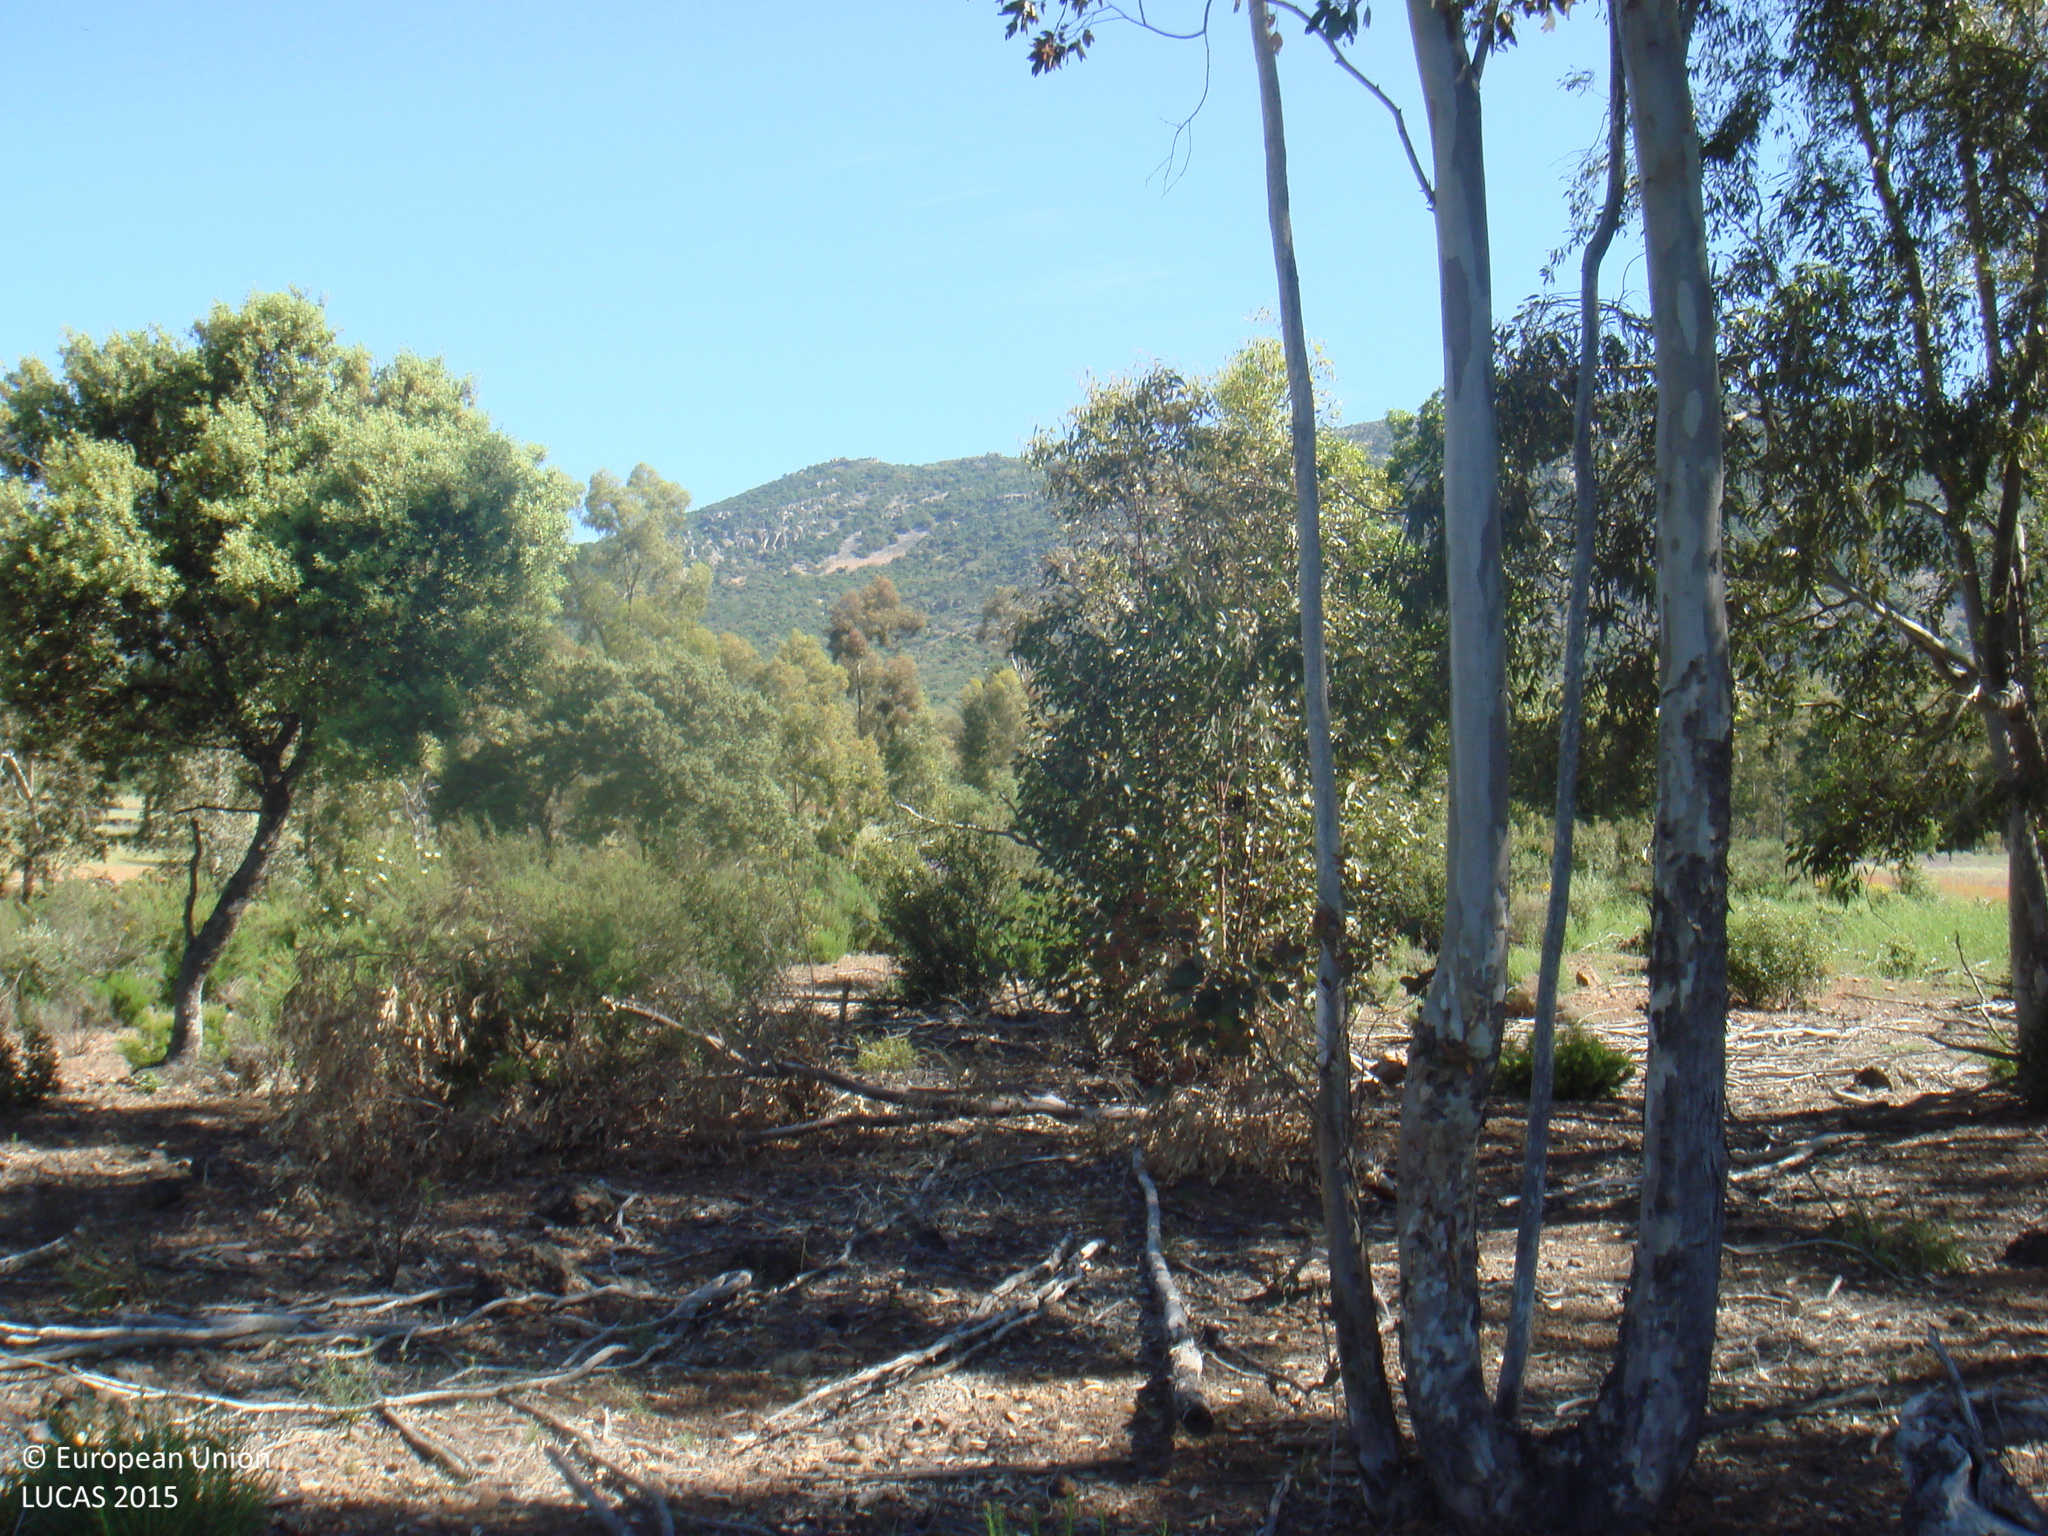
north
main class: Woodland
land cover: Broadleaved woodland
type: broadleaved evergreen forest
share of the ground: > 75 %
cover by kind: broadleaved forest trees 50 %, herbaceous plants 30 %, shrubs 20 %
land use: Forestry
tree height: > 5 m
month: May
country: ES
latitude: 38.4575
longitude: -4.4468
